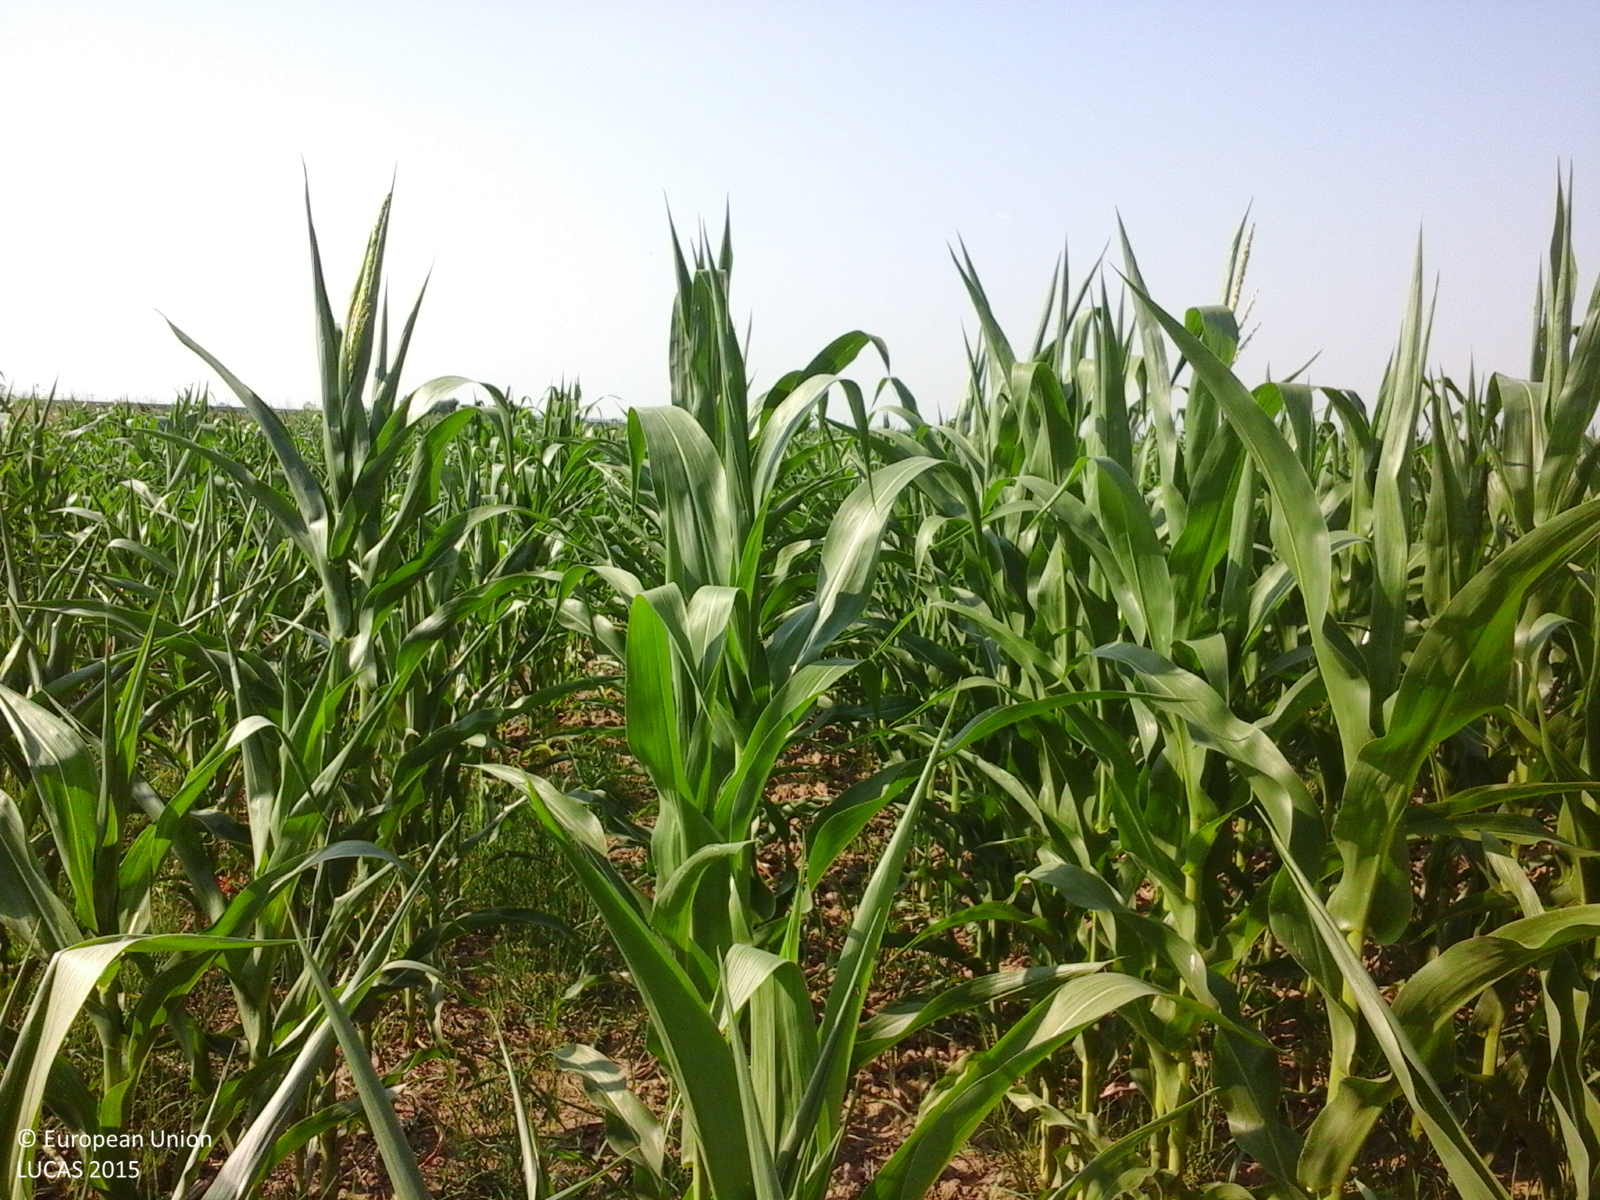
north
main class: Cropland
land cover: Maize
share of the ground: > 75 %
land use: Agriculture (excluding fallow land and kitchen gardens)
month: July
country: RO
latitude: 44.5434
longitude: 25.5622
